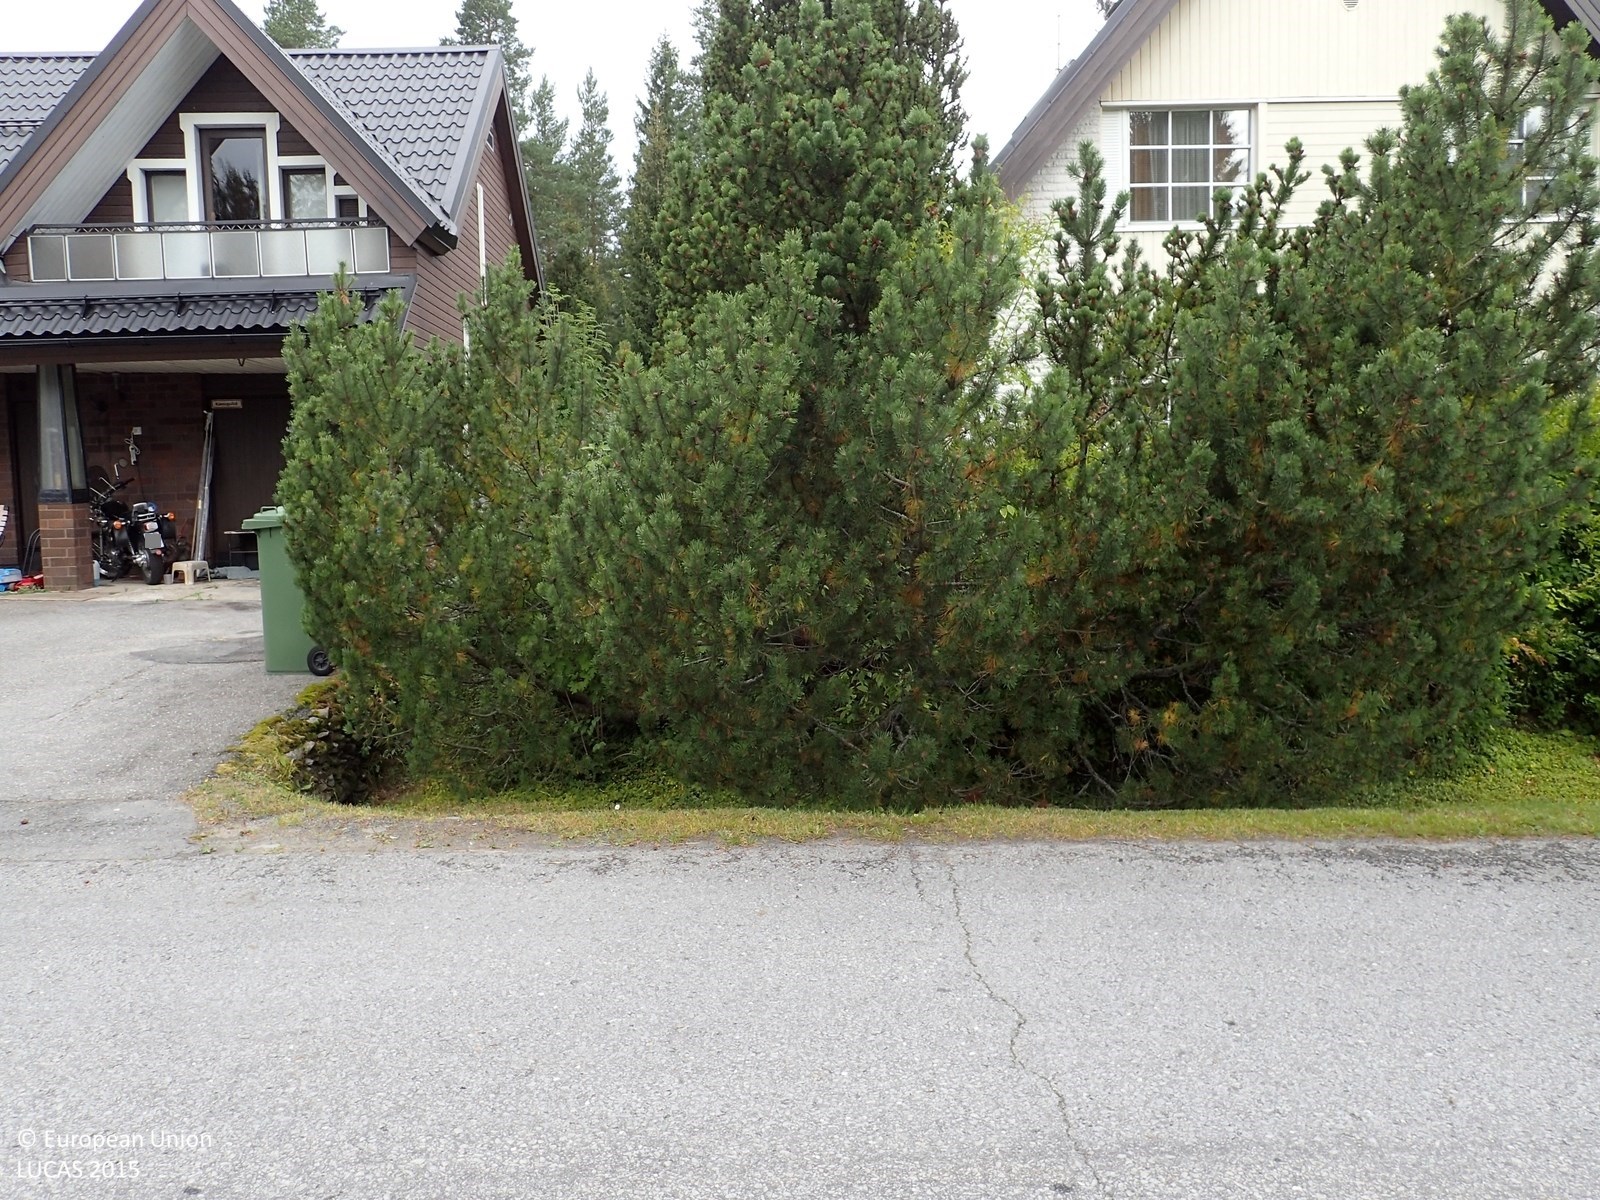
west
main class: Woodland
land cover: Broadleaved woodland
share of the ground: > 75 %
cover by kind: broadleaved forest trees 85 %, herbaceous plants 15 %
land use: Residential
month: August
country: FI
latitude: 62.7797
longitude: 22.7752
